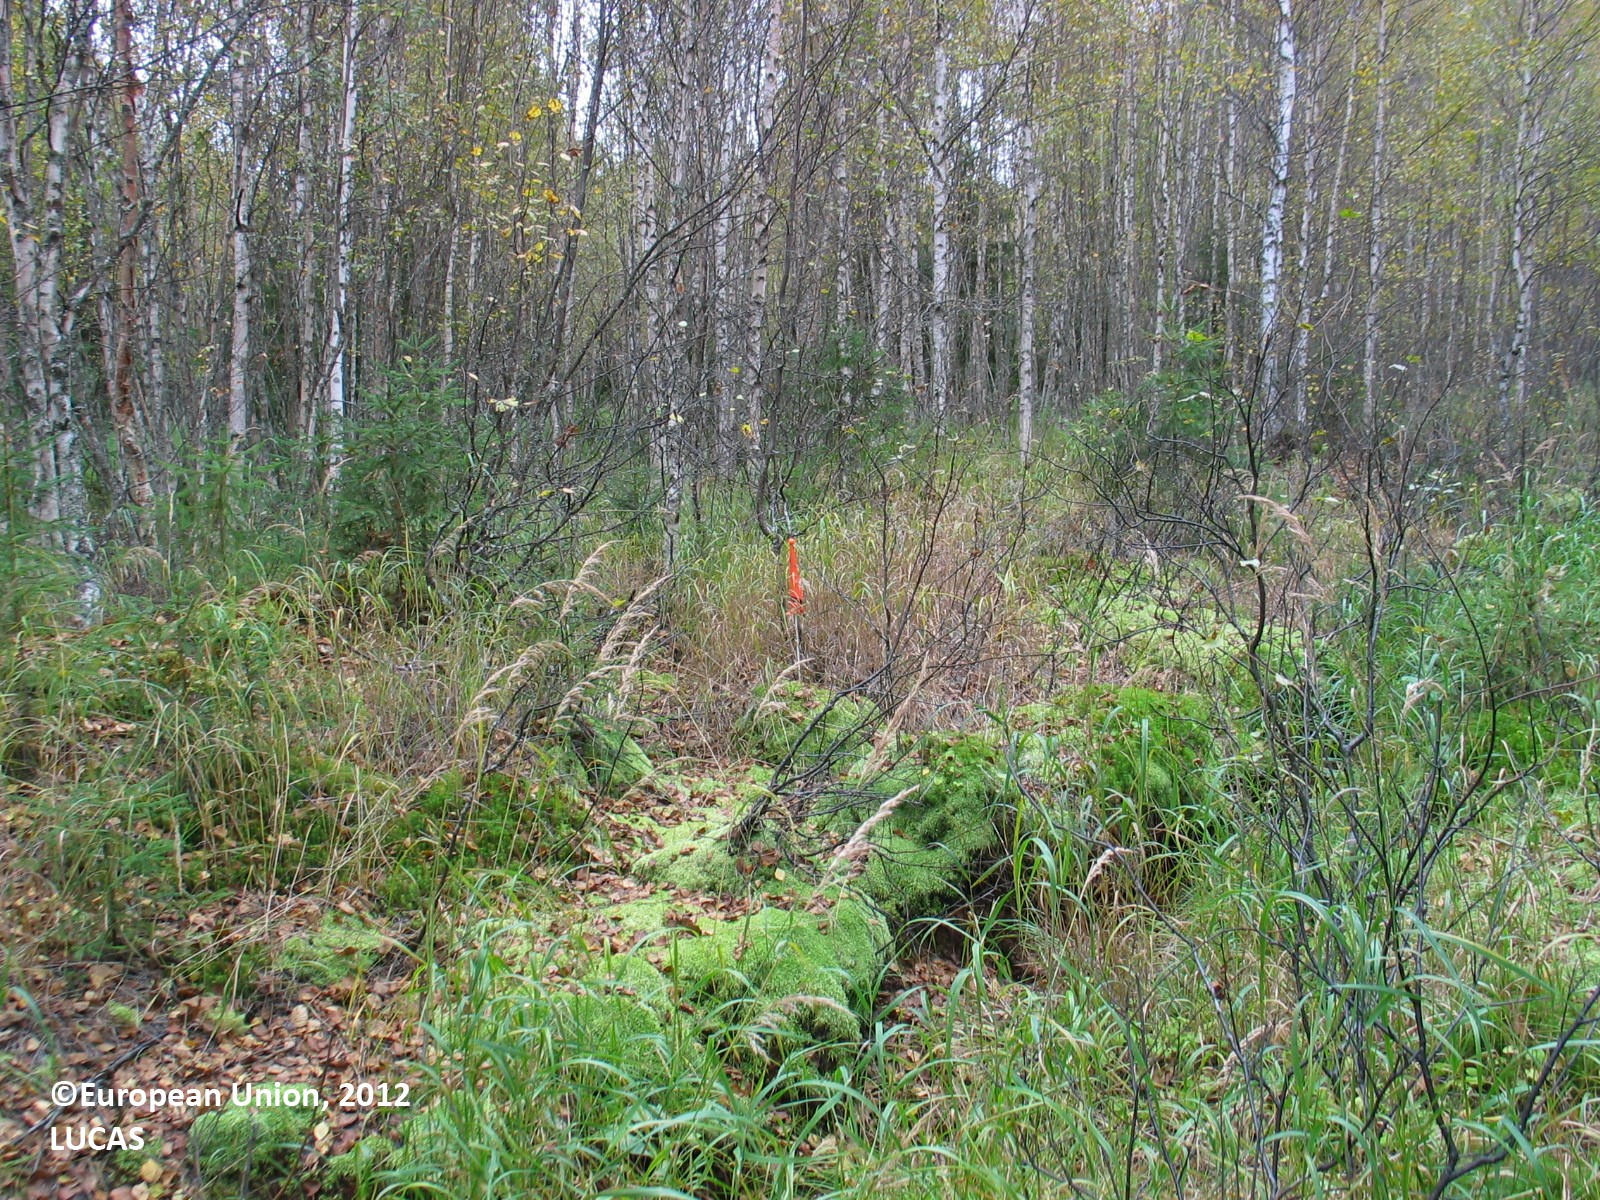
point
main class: Woodland
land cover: Broadleaved woodland
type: mire and swamp forests
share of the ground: 25 - 50 %
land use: Forestry
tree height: > 5 m
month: September
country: FI
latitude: 65.5702
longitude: 25.1289
